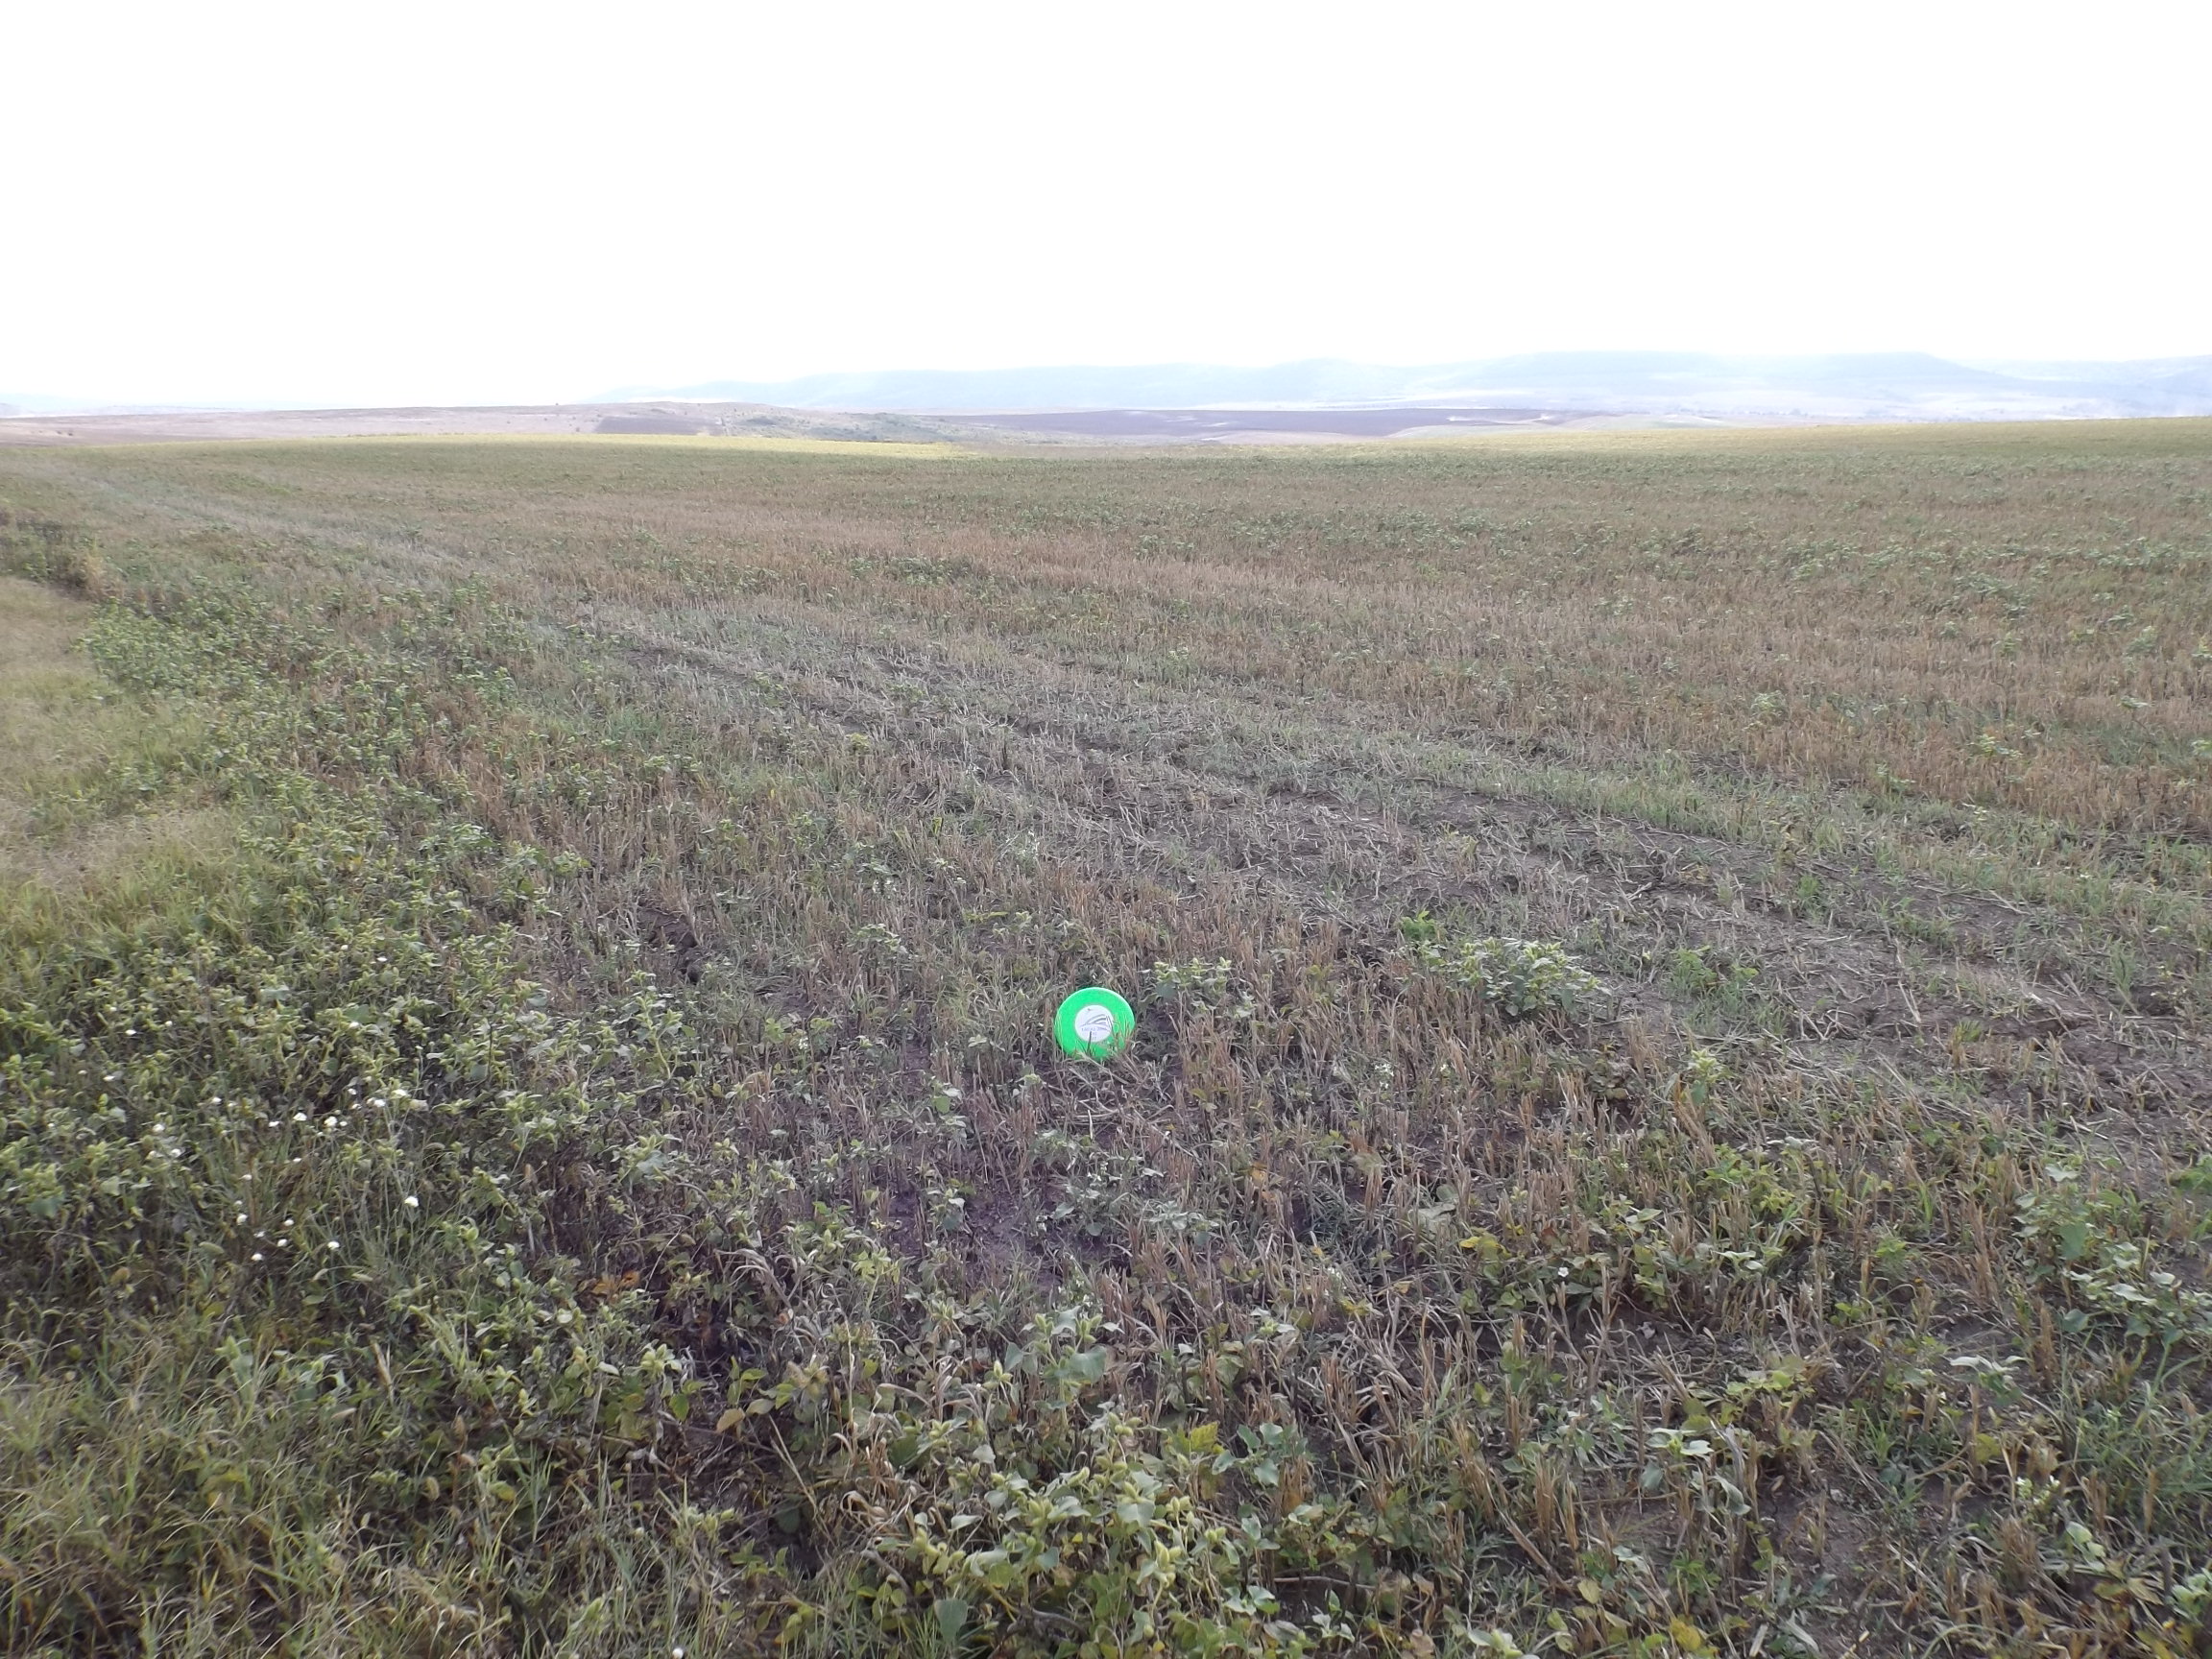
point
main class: Cropland
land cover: Other cereals
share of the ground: 10 - 25 %
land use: Agriculture (excluding fallow land and kitchen gardens)
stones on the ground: < 10 %
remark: Harvested field
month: September
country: BG
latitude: 43.2839
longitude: 27.5428
